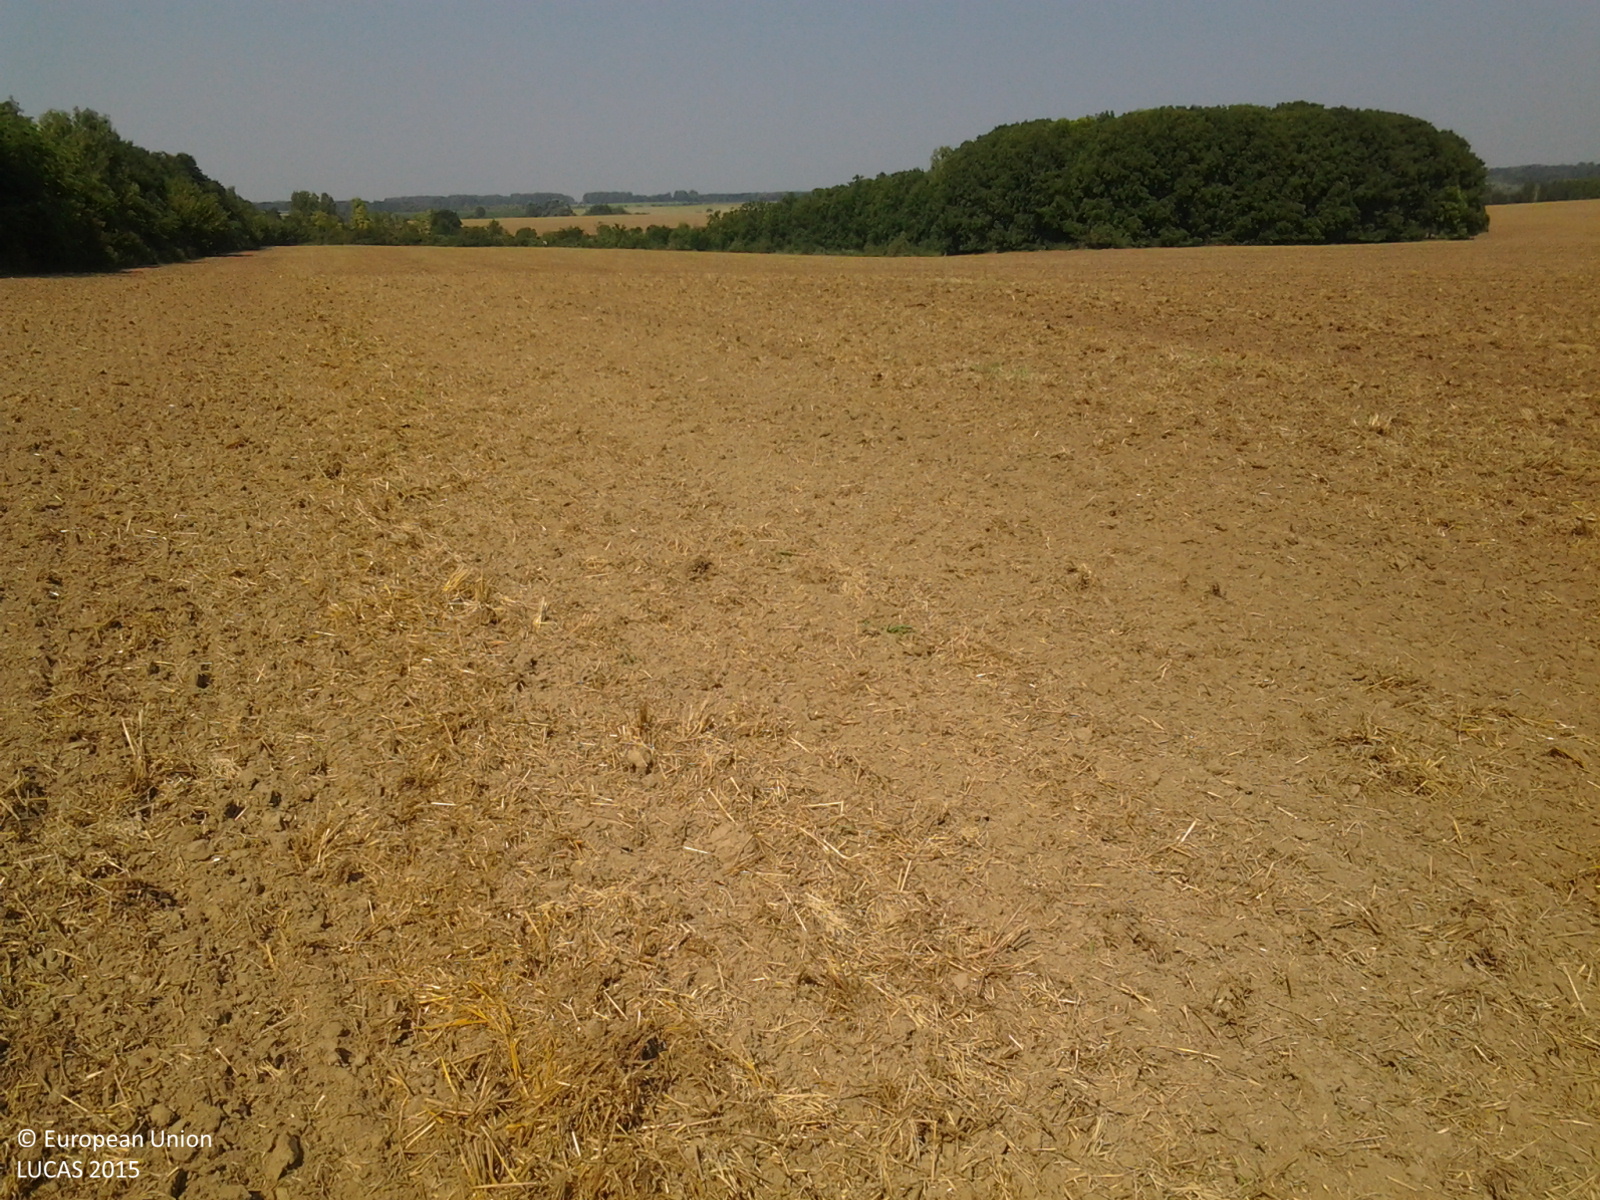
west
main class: Cropland
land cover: Common wheat
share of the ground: < 10 %
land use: Agriculture (excluding fallow land and kitchen gardens)
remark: Harvested field
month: August
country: HU
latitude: 46.4743
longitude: 18.1482
